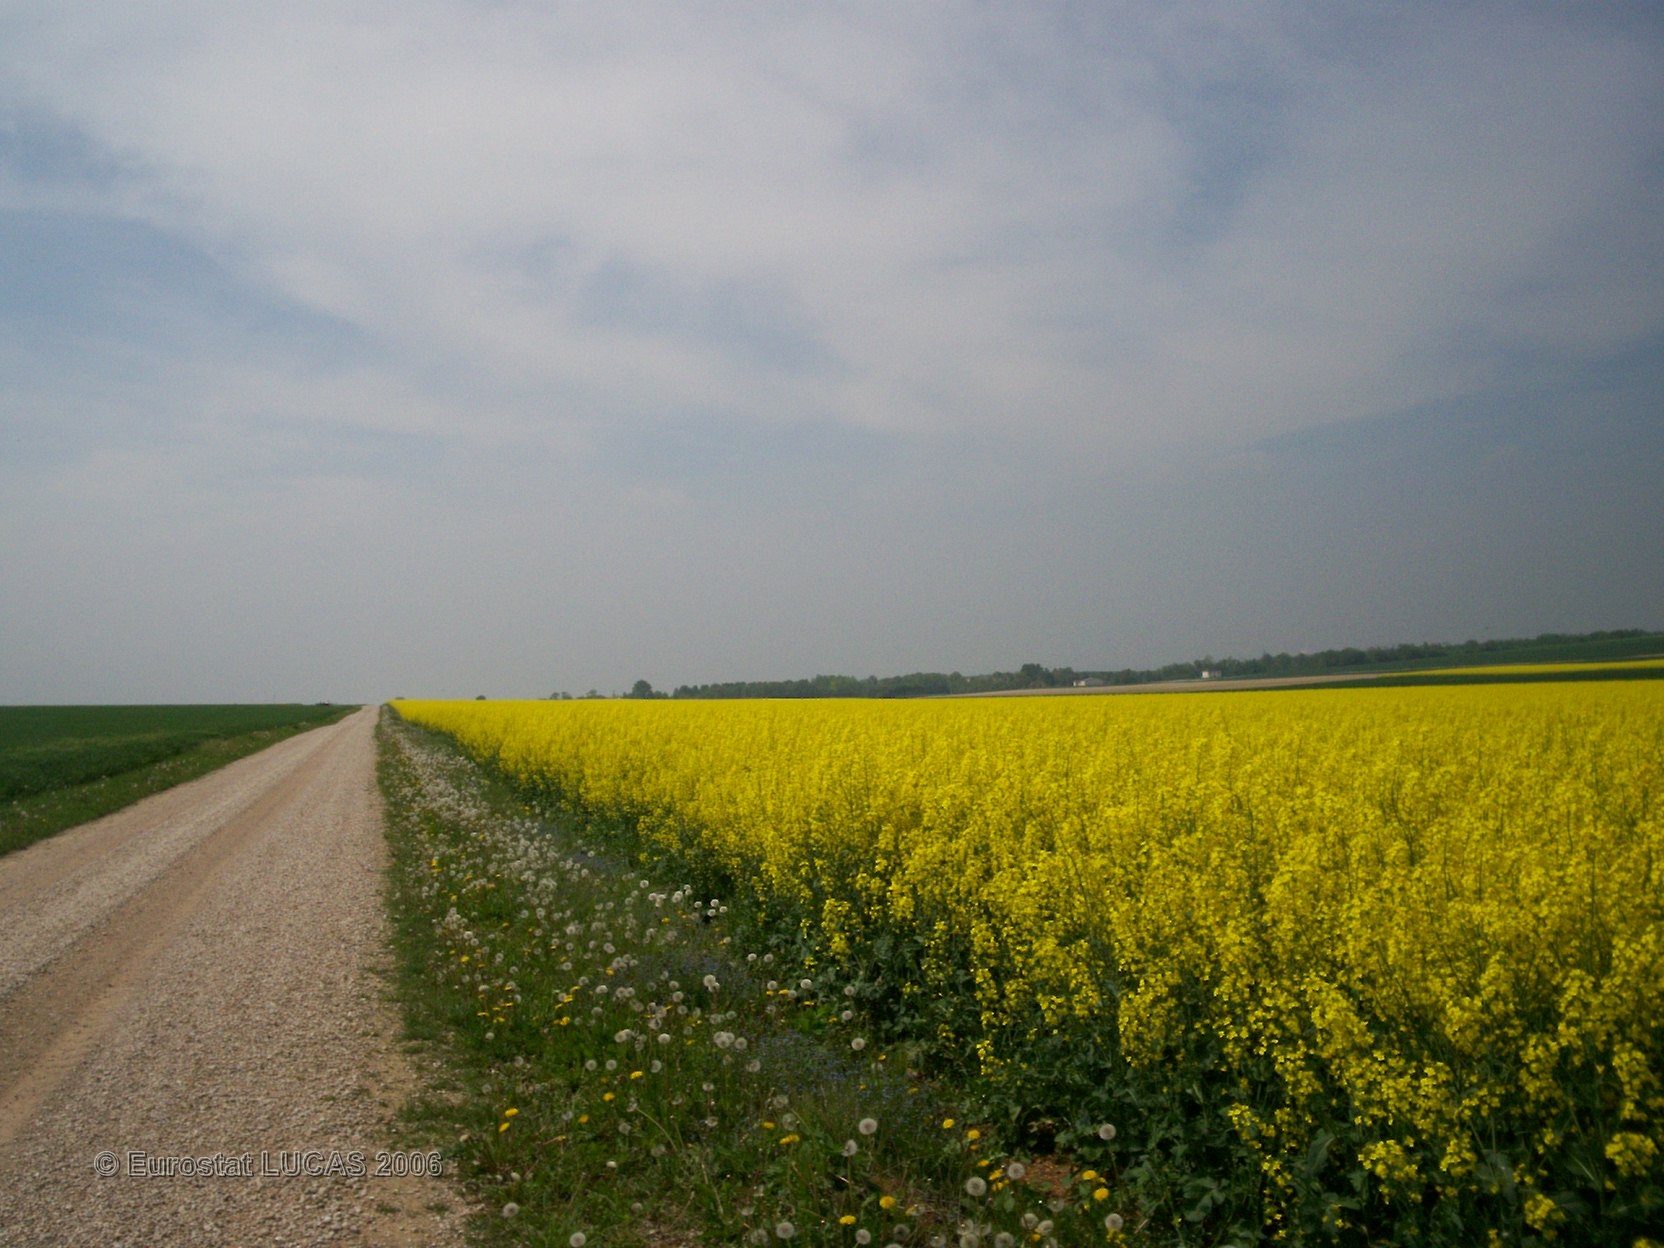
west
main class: Cropland
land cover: Rape and turnip rape
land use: Agriculture (excluding fallow land and kitchen gardens)
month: May
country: FR
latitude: 49.0040
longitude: 4.4602
